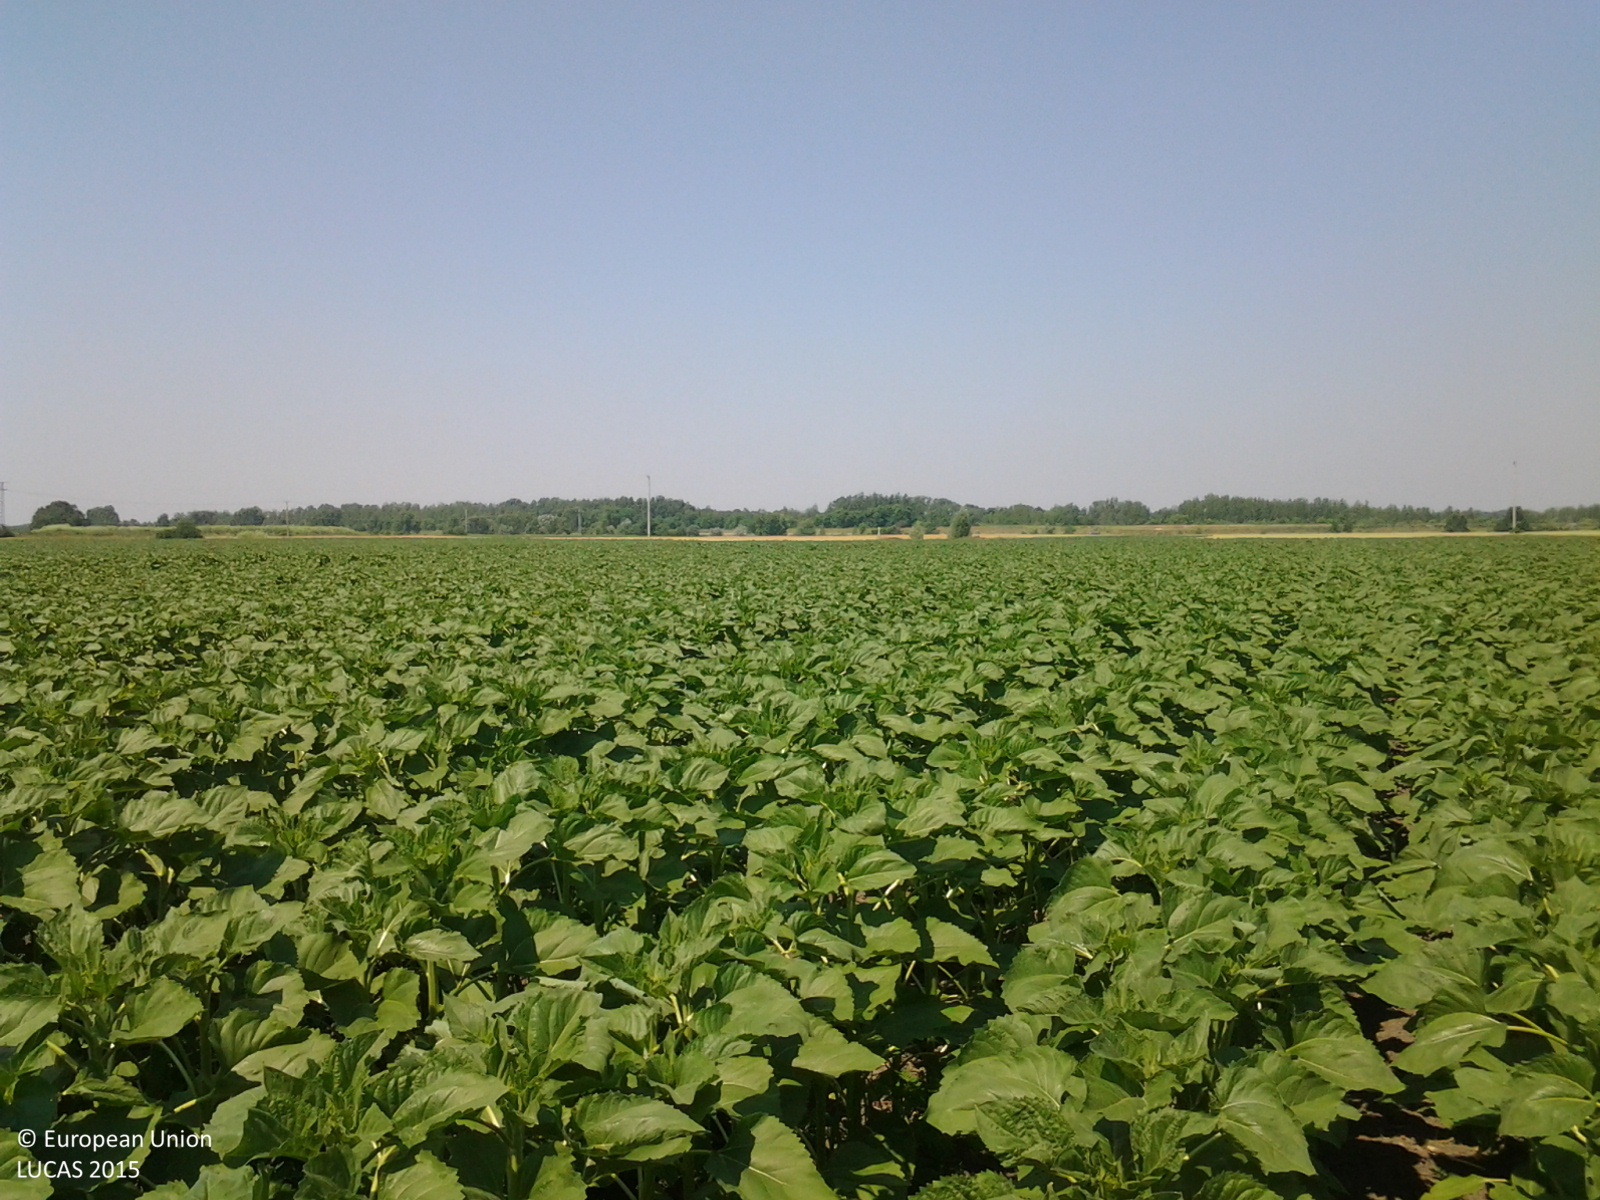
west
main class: Cropland
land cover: Sunflower
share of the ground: > 75 %
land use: Agriculture (excluding fallow land and kitchen gardens)
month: June
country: HU
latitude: 46.6581
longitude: 19.0183
